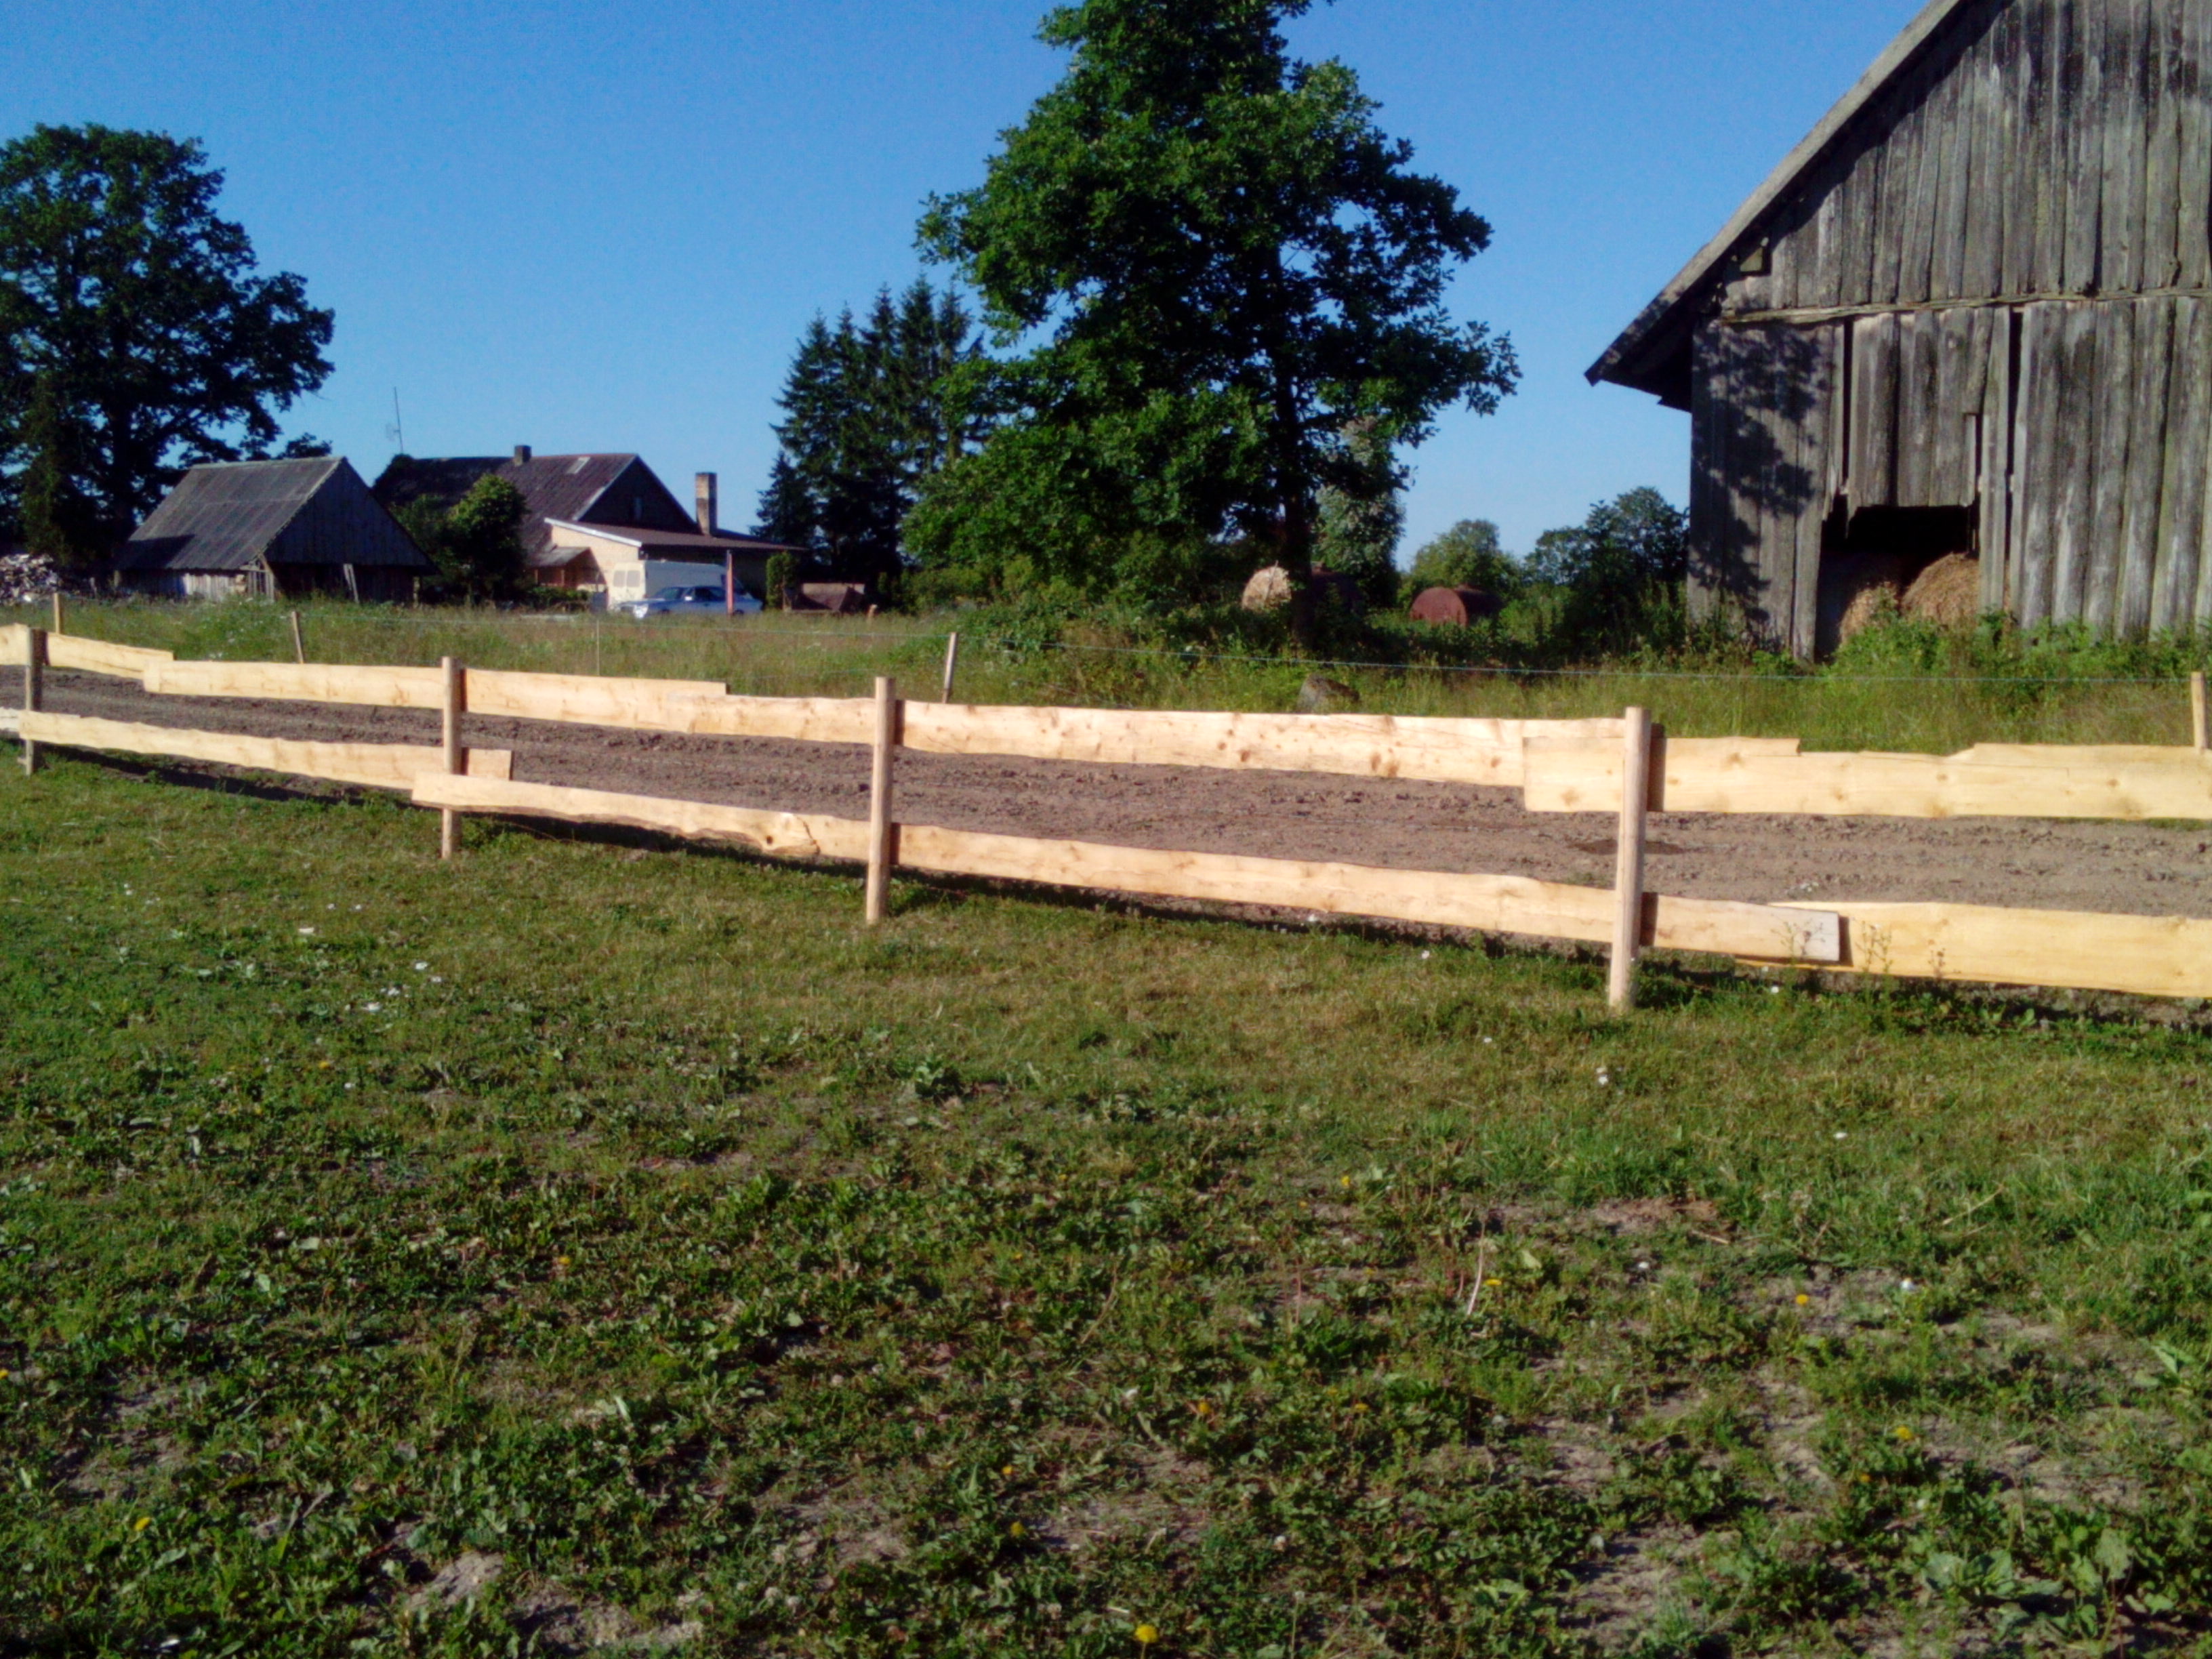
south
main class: Grassland
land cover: Grassland without tree/shrub cover
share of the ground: > 75 %
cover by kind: herbaceous plants 80 %, unconsolidated bare surface 20 %
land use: Agriculture (excluding fallow land and kitchen gardens)
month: July
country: LV
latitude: 56.4258
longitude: 22.1638
